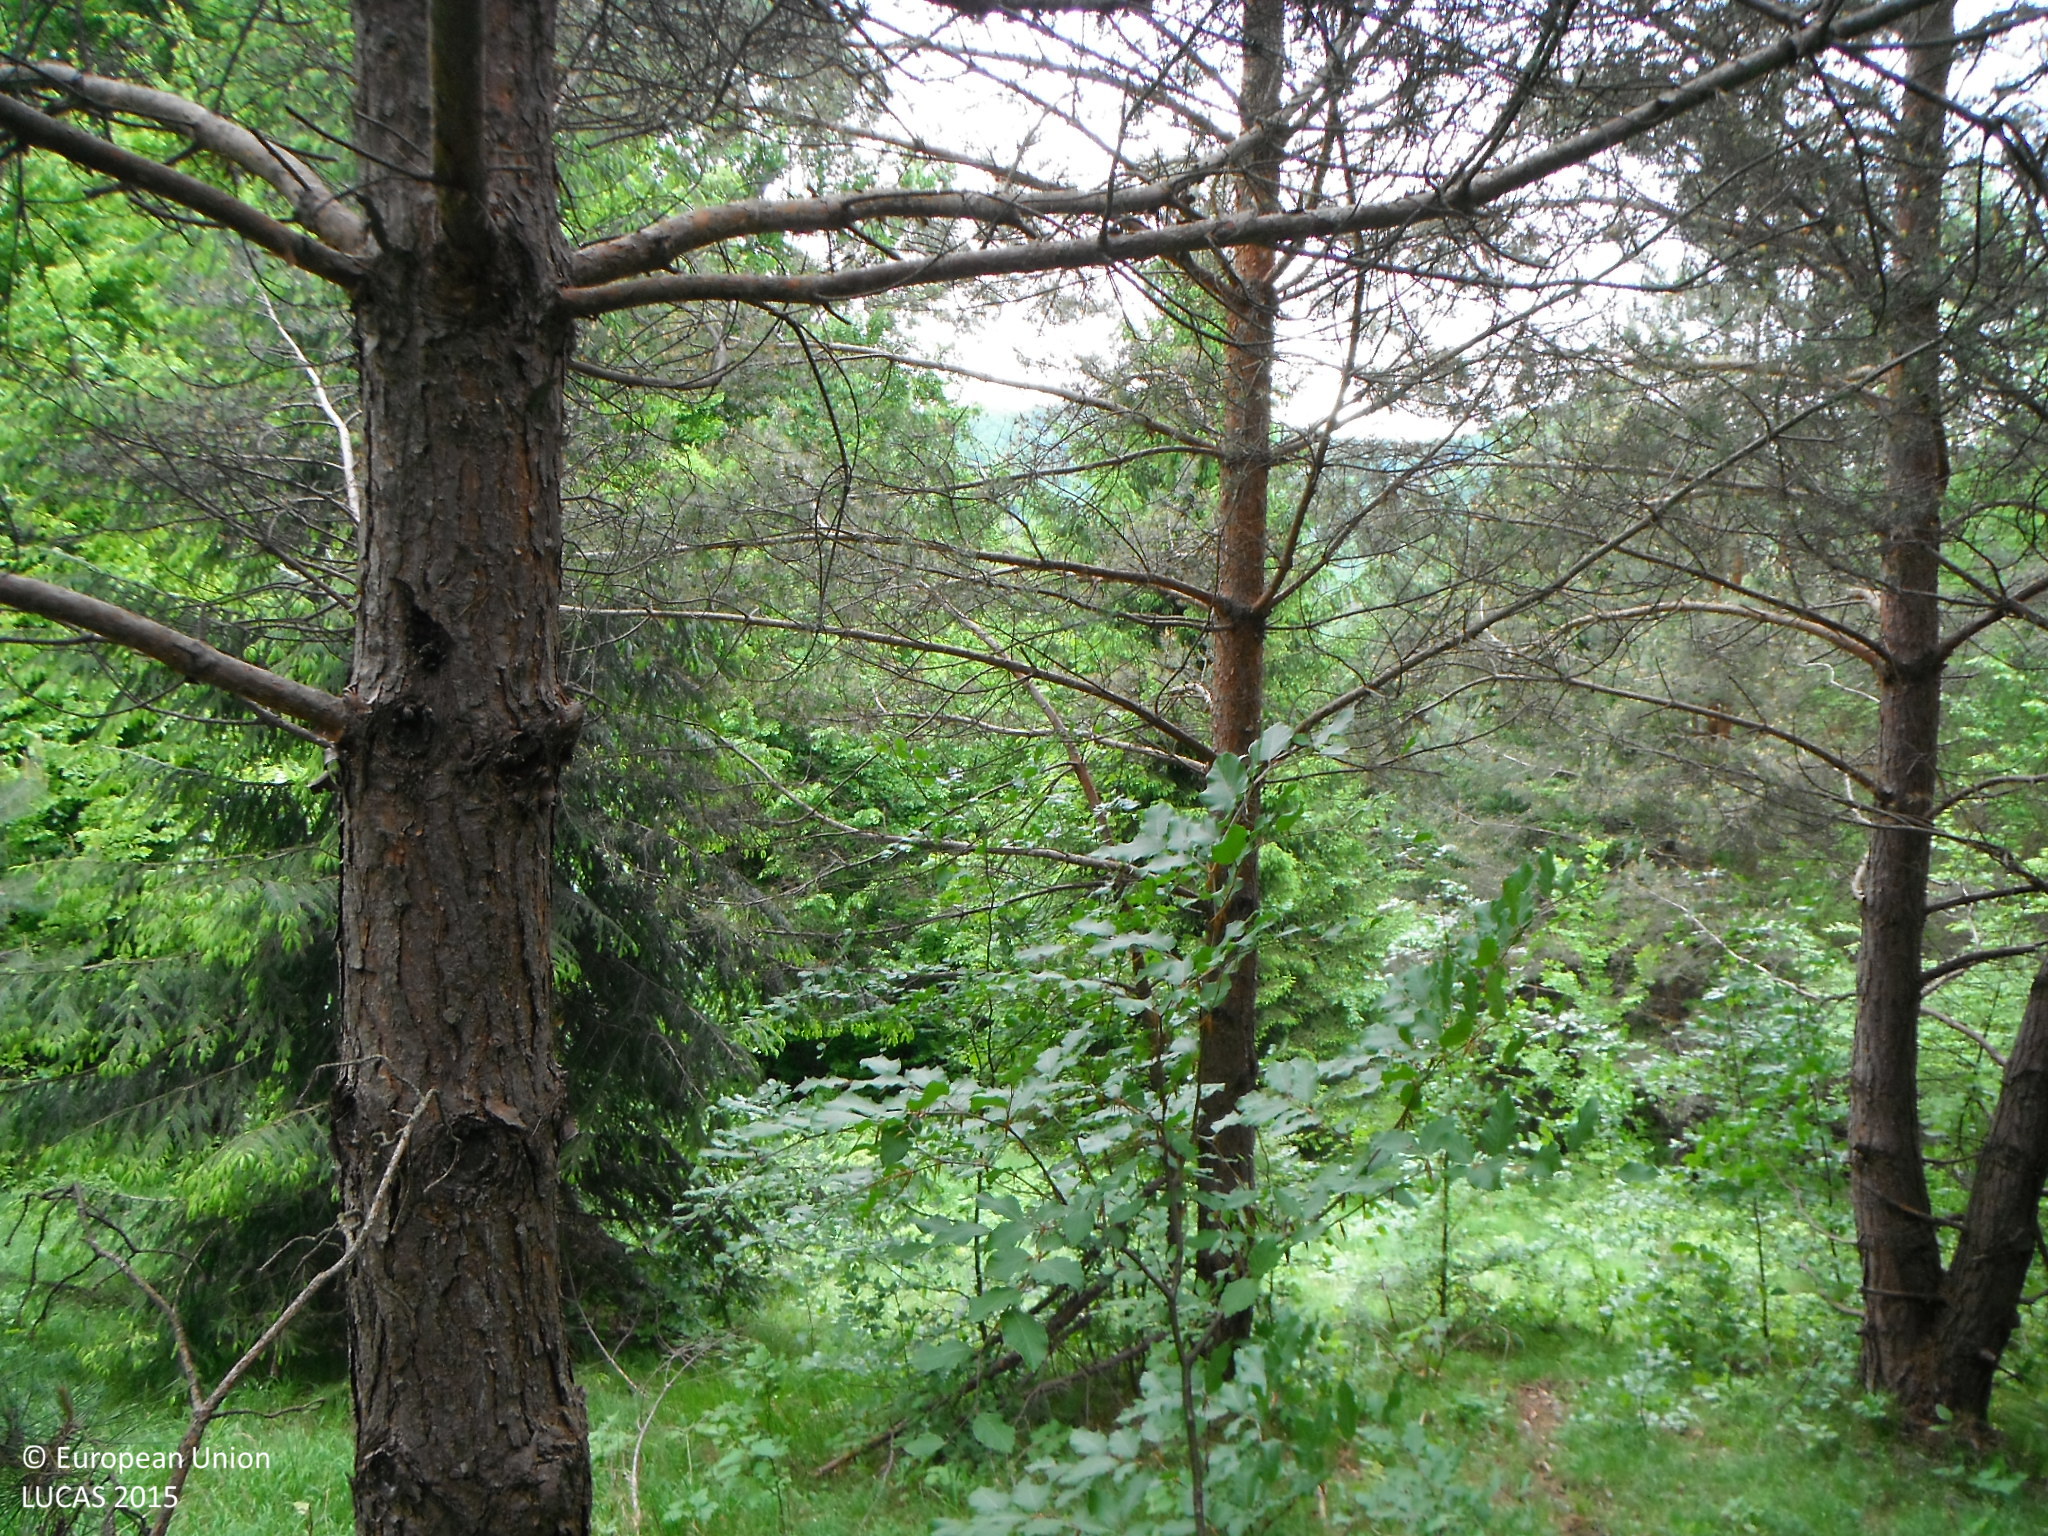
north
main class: Woodland
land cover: Pine dominated mixed woodland
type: hemiboreal forest and nemoral coniferous forest and mixed broadleaved-coniferous forest
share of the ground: > 75 %
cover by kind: broadleaved forest trees 55 %, coniferous forest trees 40 %, herbaceous plants 5 %
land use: Forestry
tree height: > 5 m
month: May
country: SK
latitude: 48.7545
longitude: 19.0670
